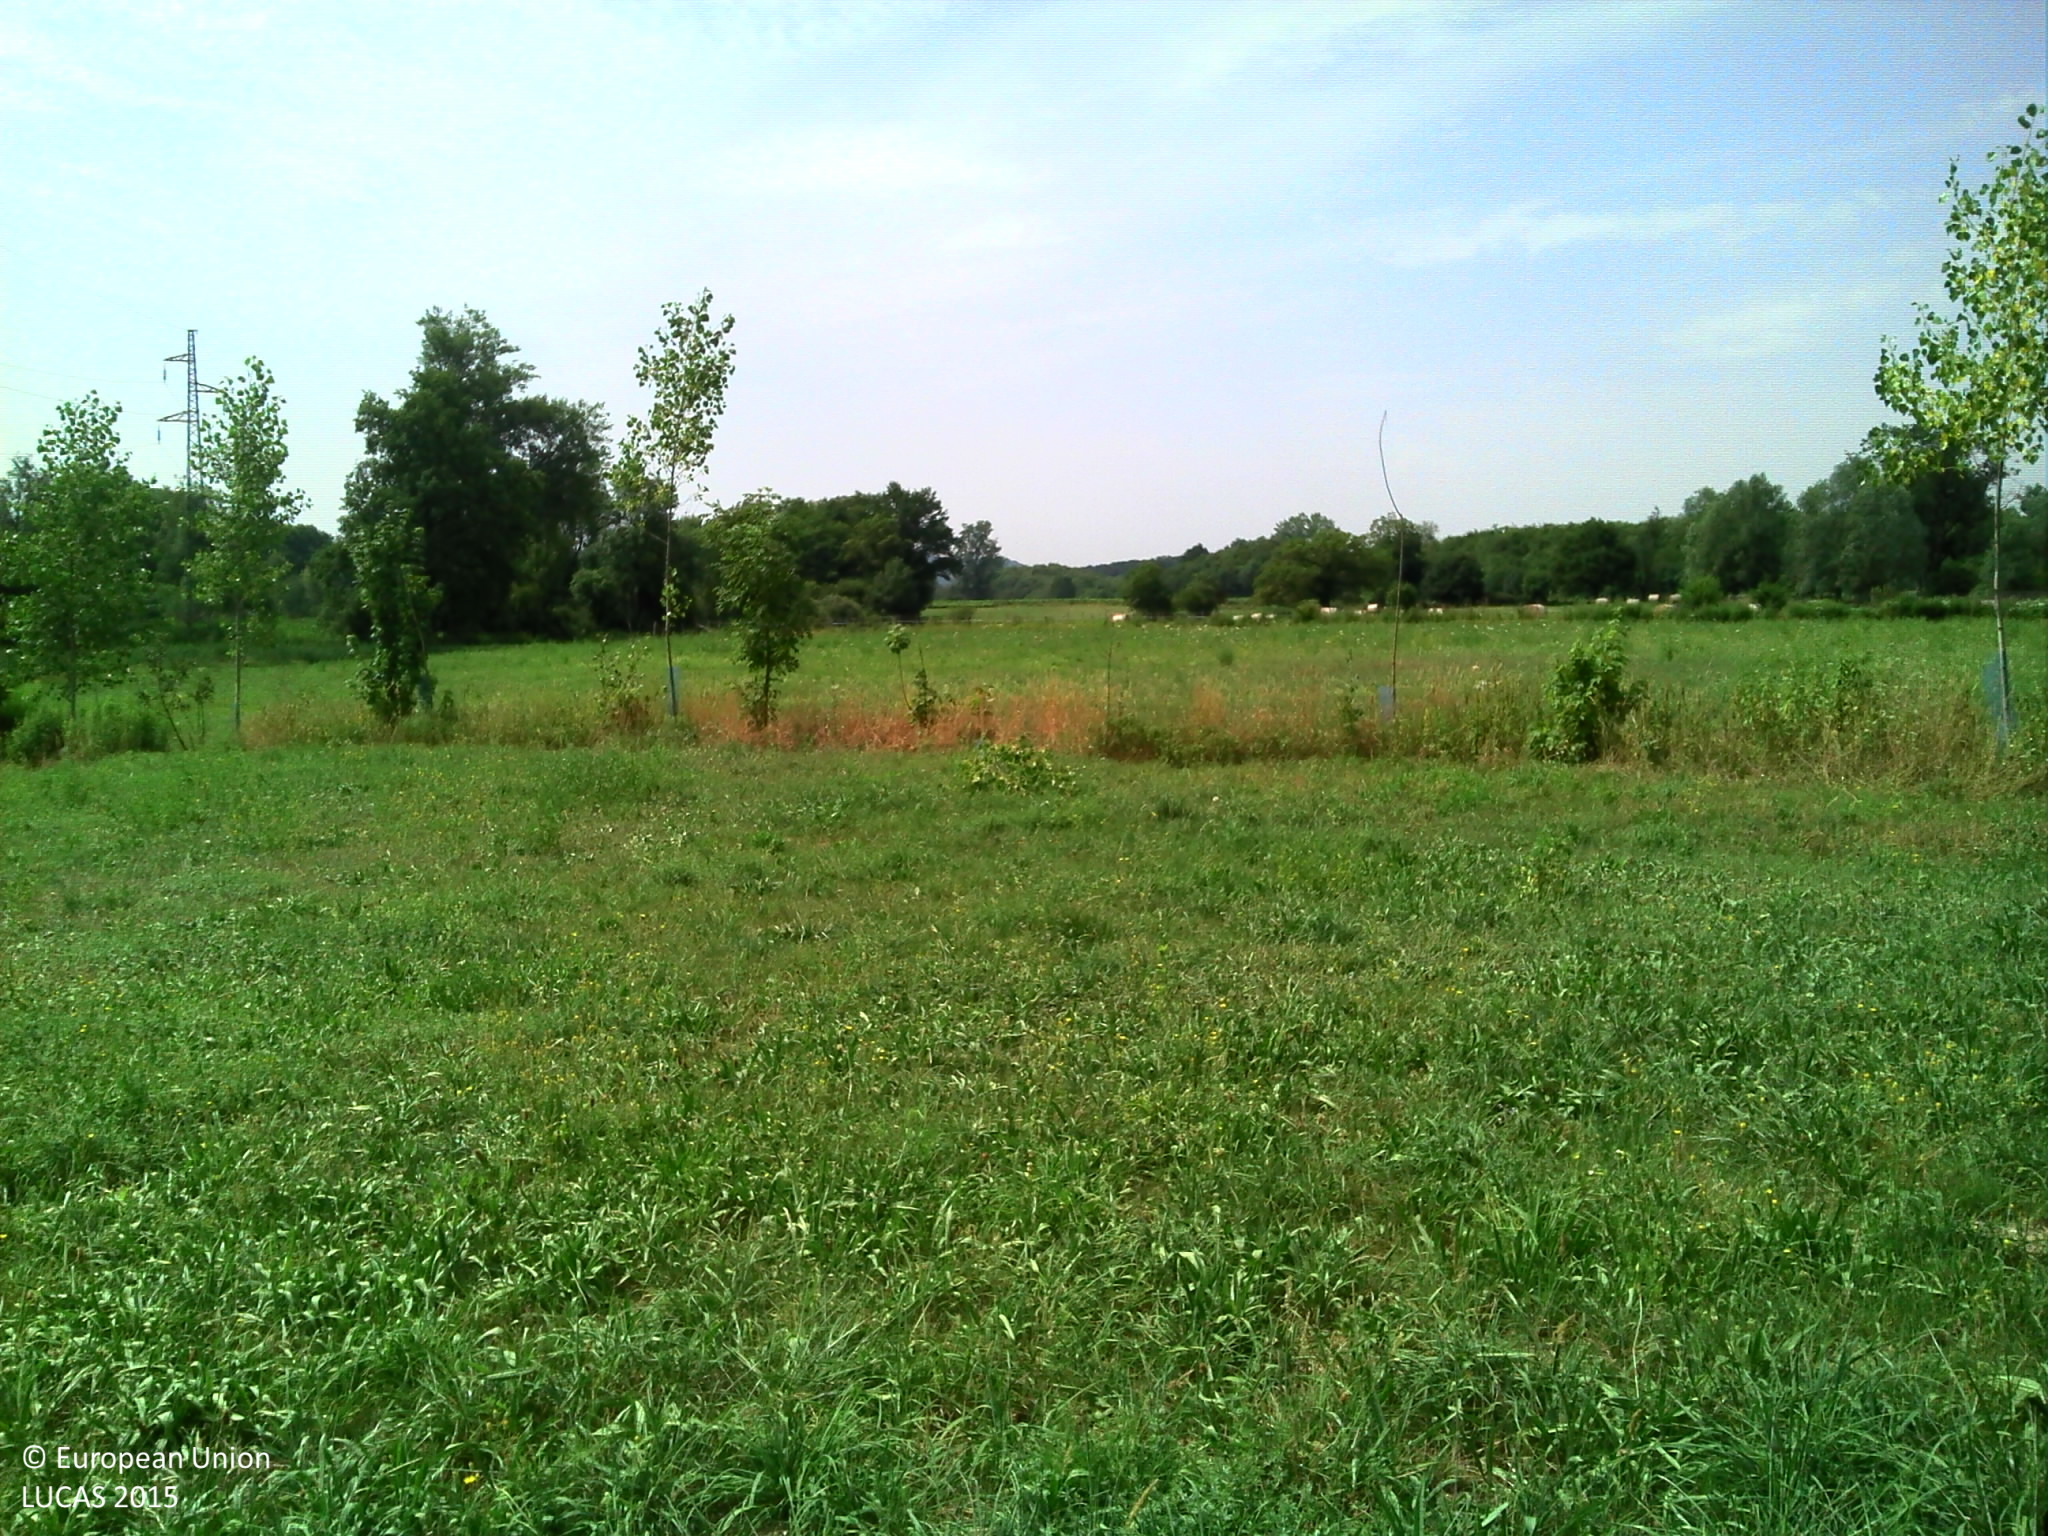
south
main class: Grassland
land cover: Grassland with sparse tree/shrub cover
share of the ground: > 75 %
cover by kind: herbaceous plants 95 %, broadleaved forest trees 5 %
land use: Agriculture (excluding fallow land and kitchen gardens)
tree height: > 5 m
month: July
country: FR
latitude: 45.7298
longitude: 5.4167
